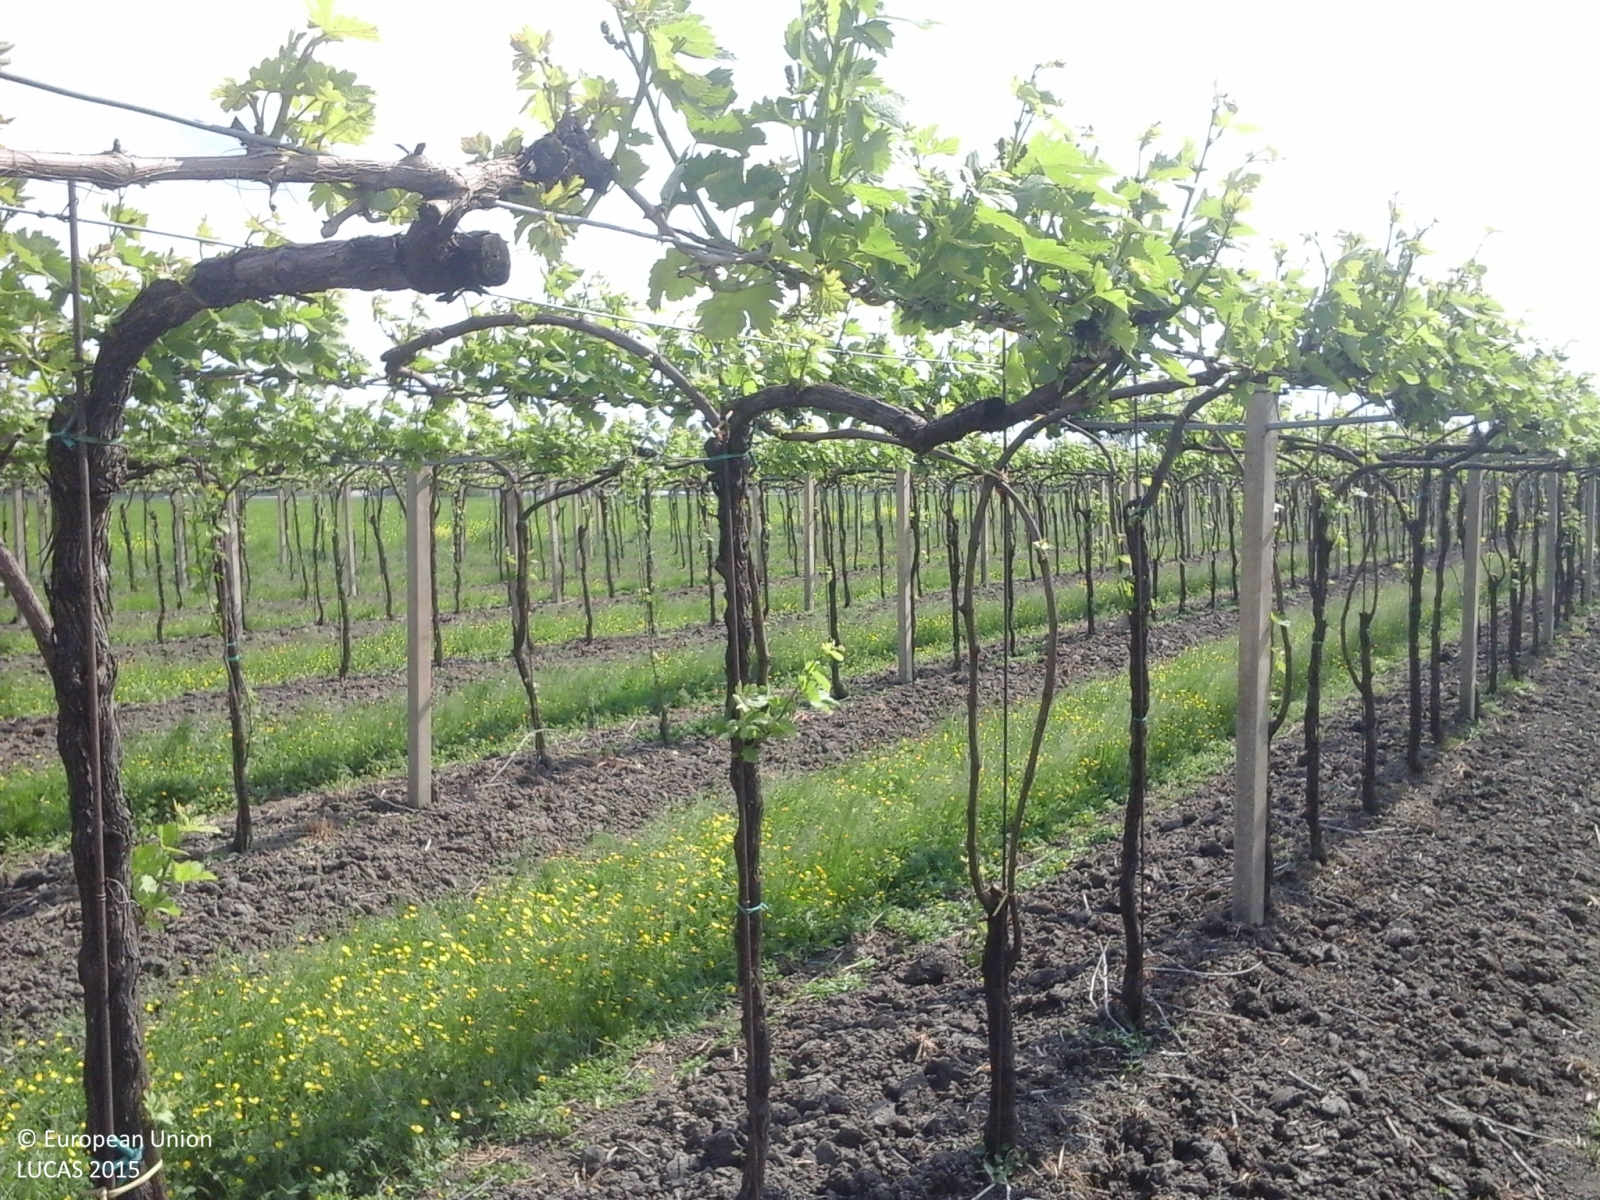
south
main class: Cropland
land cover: Vineyards
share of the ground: 10 - 25 %
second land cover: Grassland without tree/shrub cover
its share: 25 - 50 %
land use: Agriculture (excluding fallow land and kitchen gardens)
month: April
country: IT
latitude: 44.8522
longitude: 10.8208
